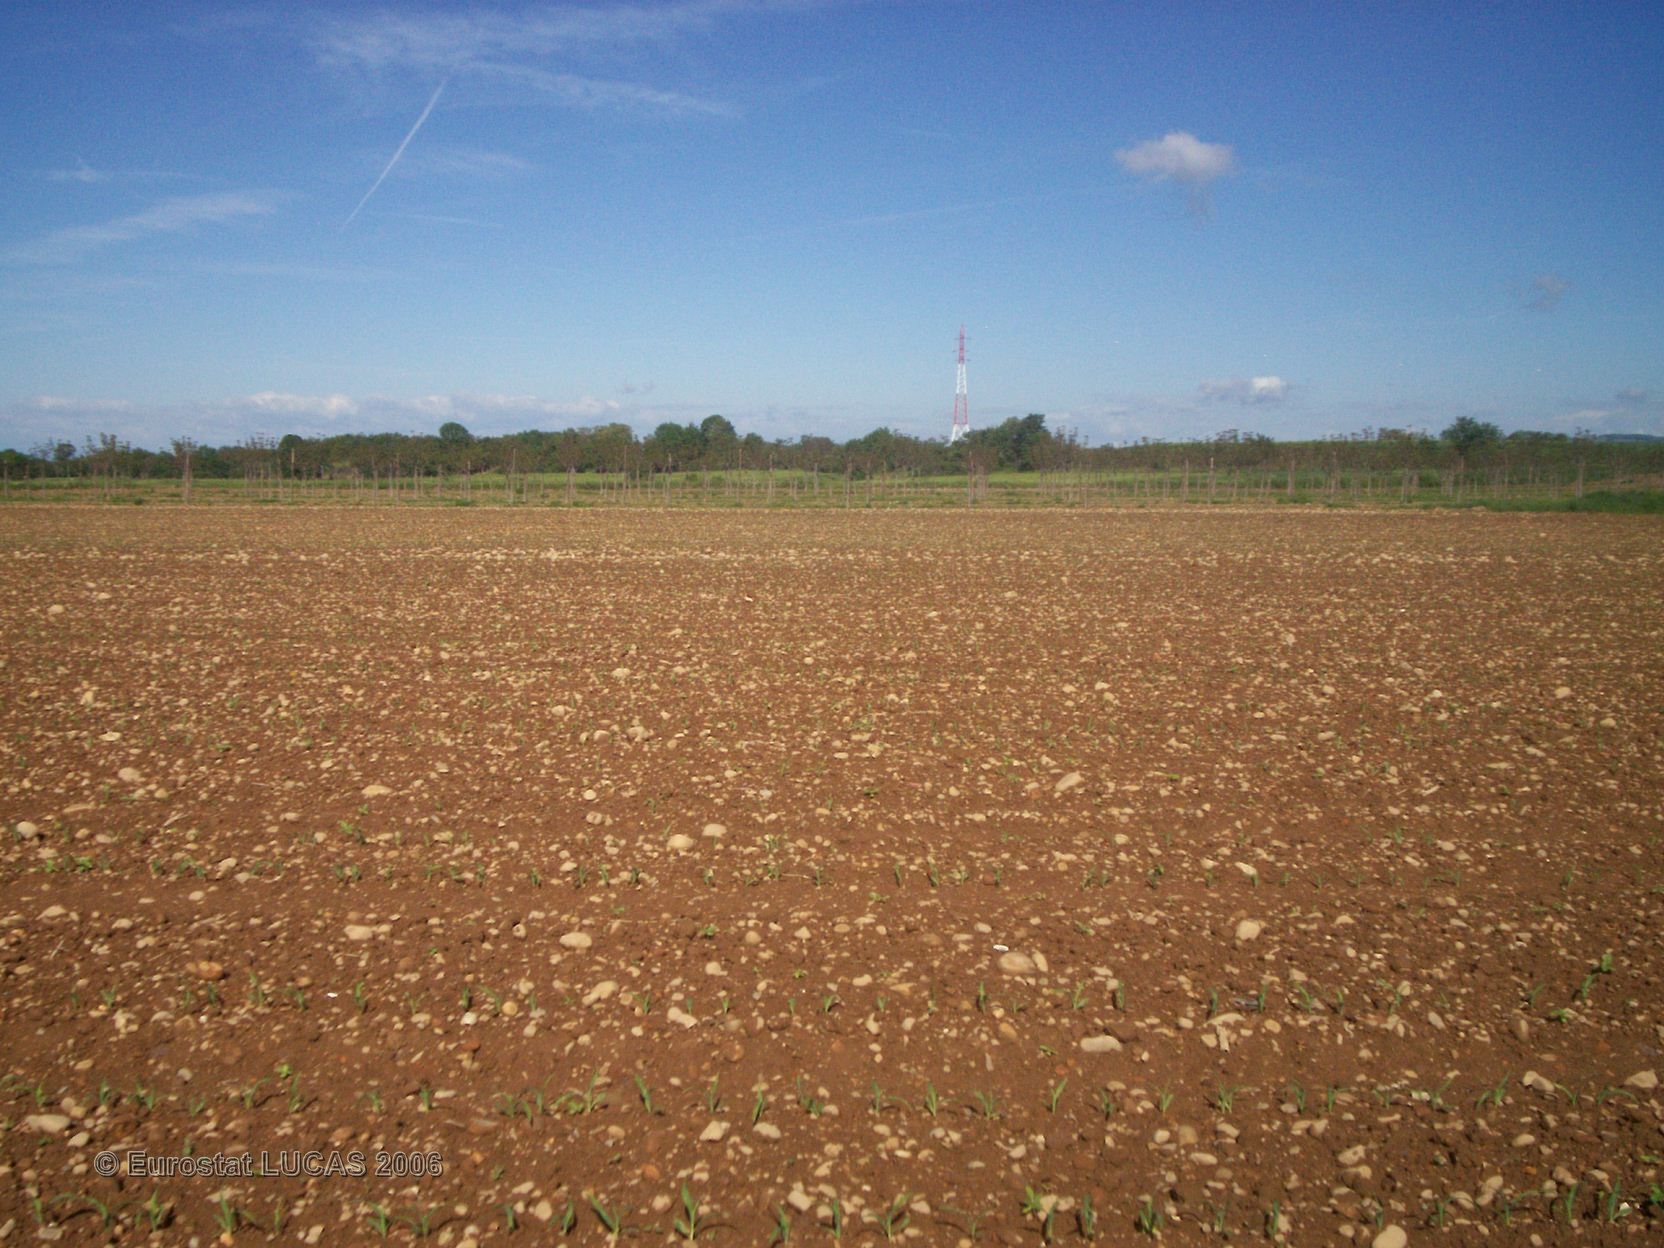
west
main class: Cropland
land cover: Maize
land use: Agriculture (excluding fallow land and kitchen gardens)
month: May
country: FR
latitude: 45.3510
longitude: 5.4227
